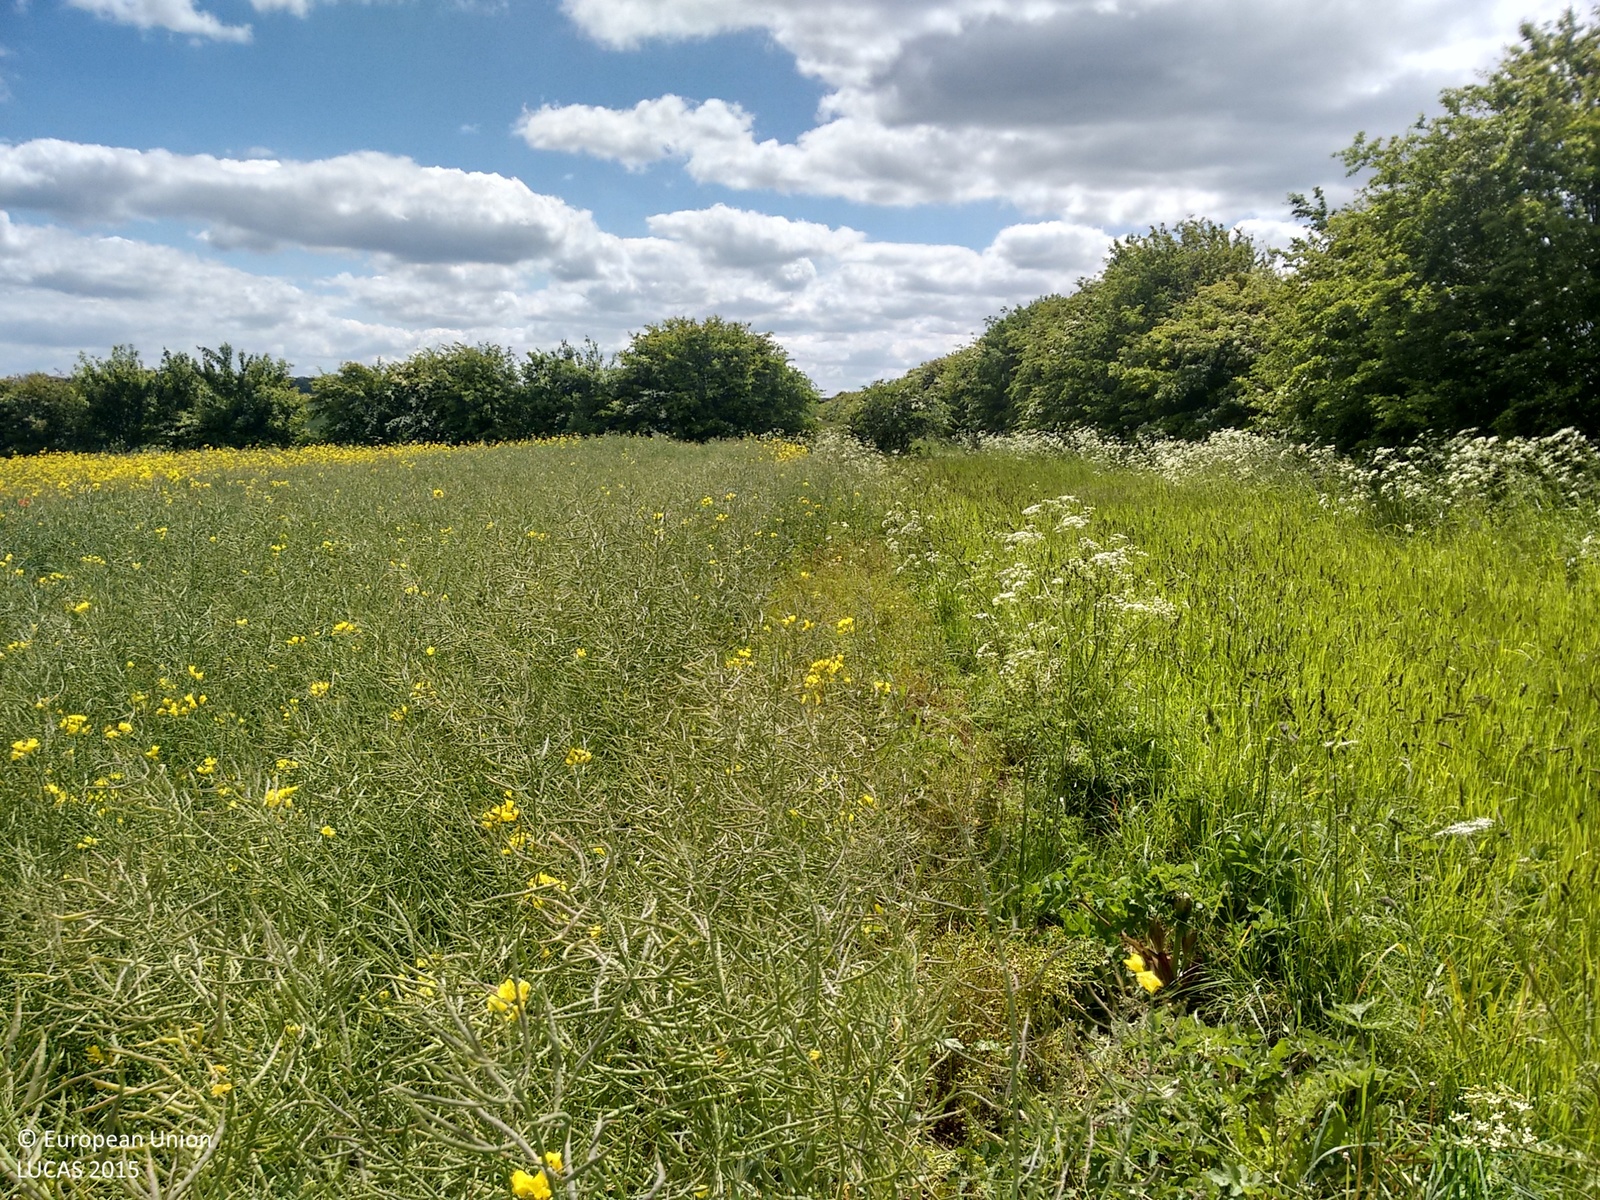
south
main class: Cropland
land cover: Rape and turnip rape
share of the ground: > 75 %
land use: Agriculture (excluding fallow land and kitchen gardens)
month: June
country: GB
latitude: 53.4468
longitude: -0.1362
